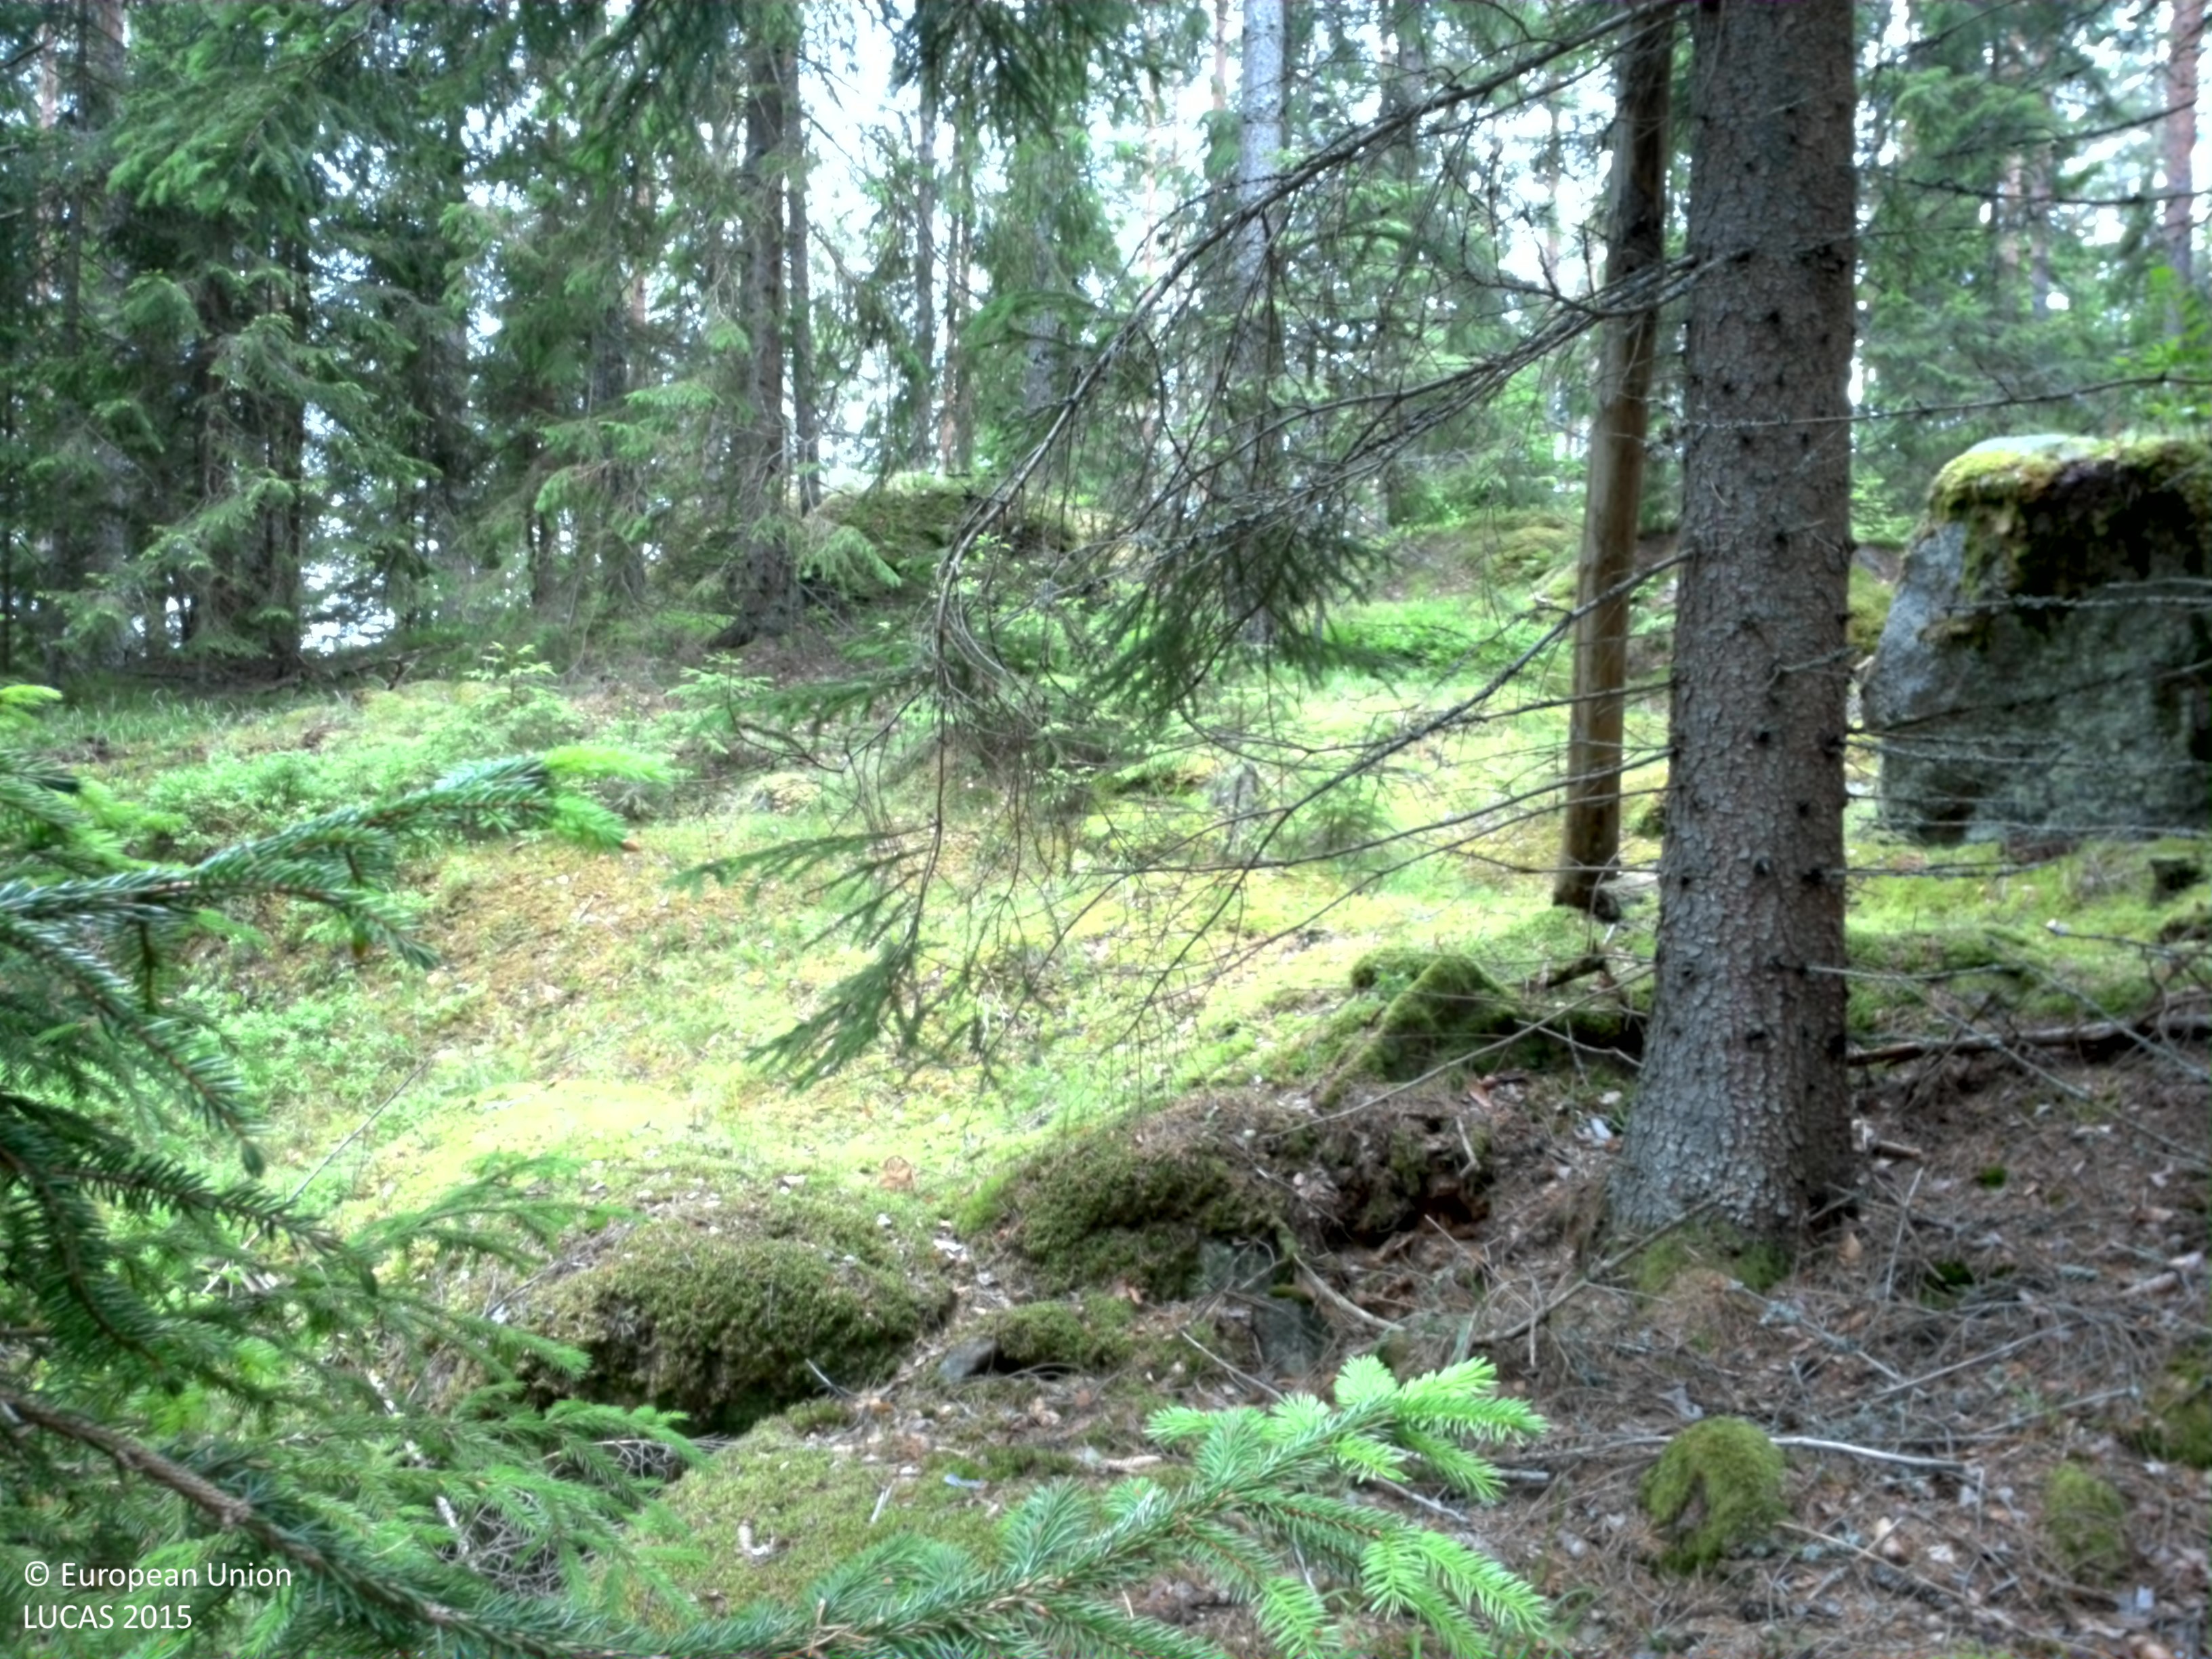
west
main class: Woodland
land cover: Spruce dominated coniferous woodland
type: boreal forest
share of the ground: 25 - 50 %
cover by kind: lichens and mosses 55 %, coniferous forest trees 40 %, herbaceous plants 5 %
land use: Forestry
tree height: > 5 m
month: June
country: SE
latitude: 58.6319
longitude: 15.4537
